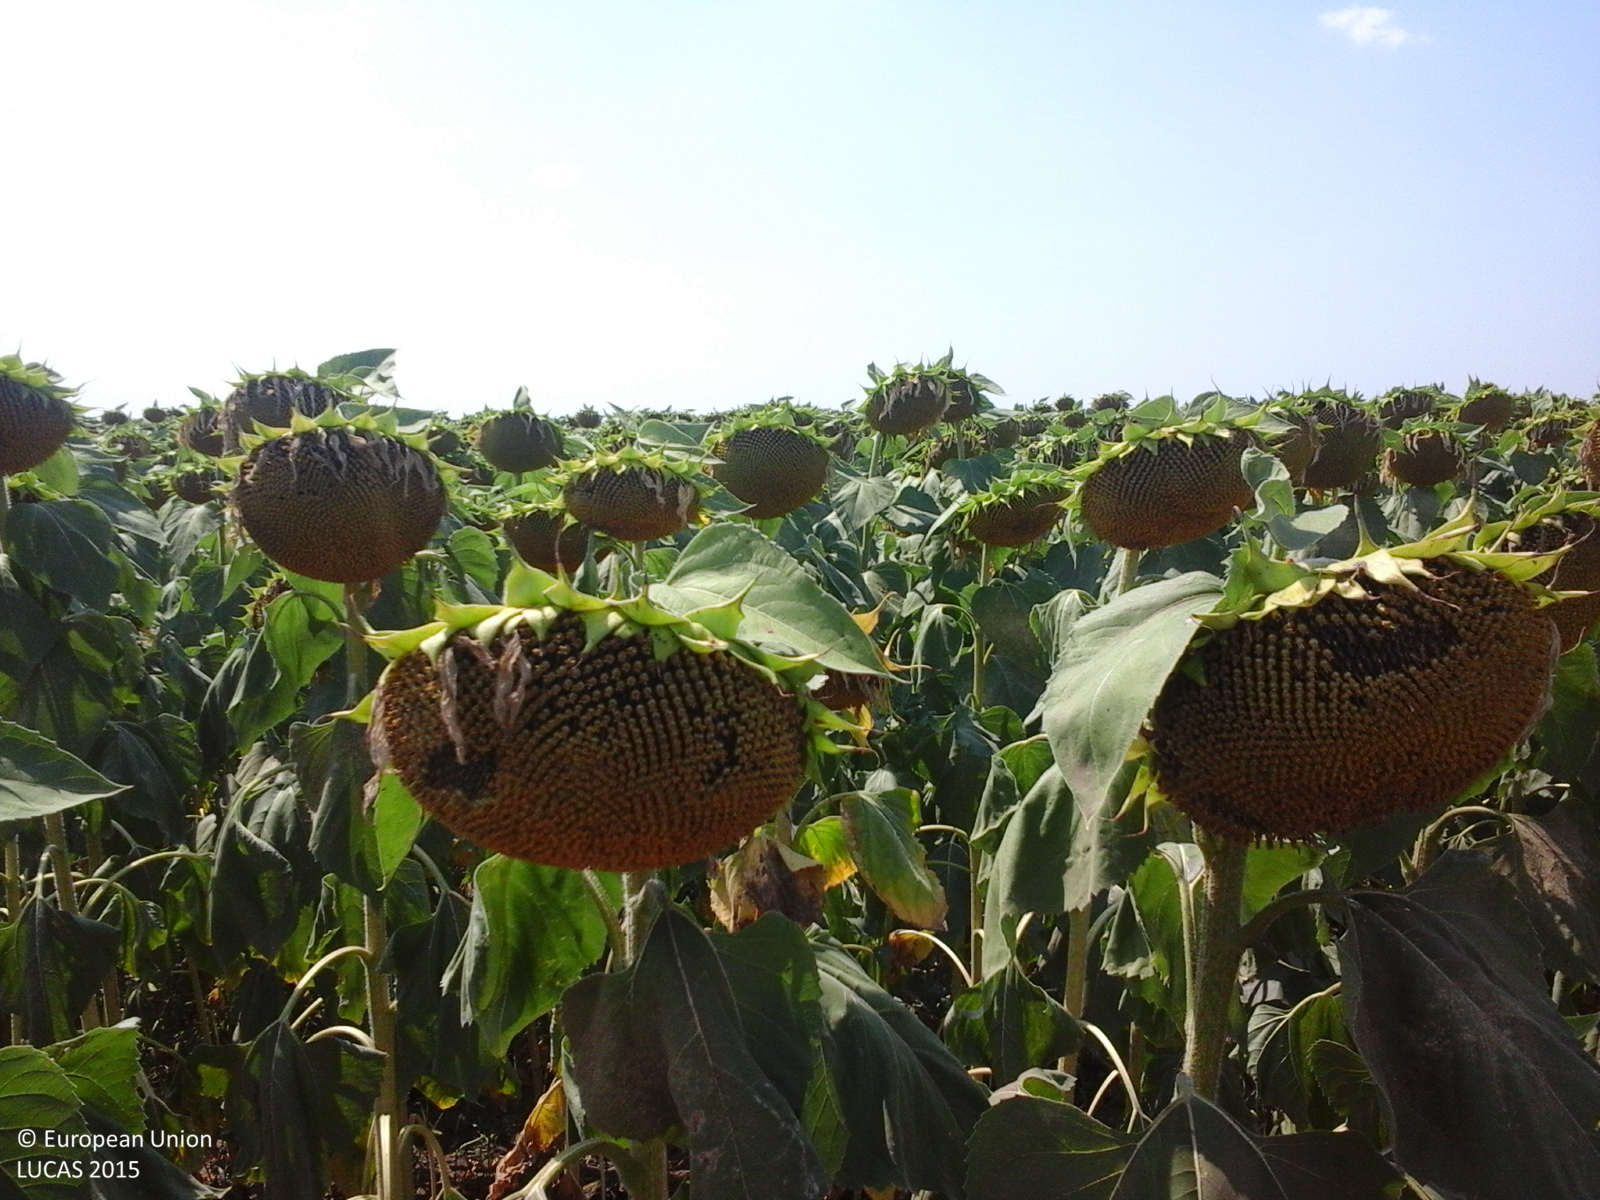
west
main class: Cropland
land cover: Sunflower
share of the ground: > 75 %
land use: Agriculture (excluding fallow land and kitchen gardens)
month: July
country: RO
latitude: 45.9122
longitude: 27.5770
